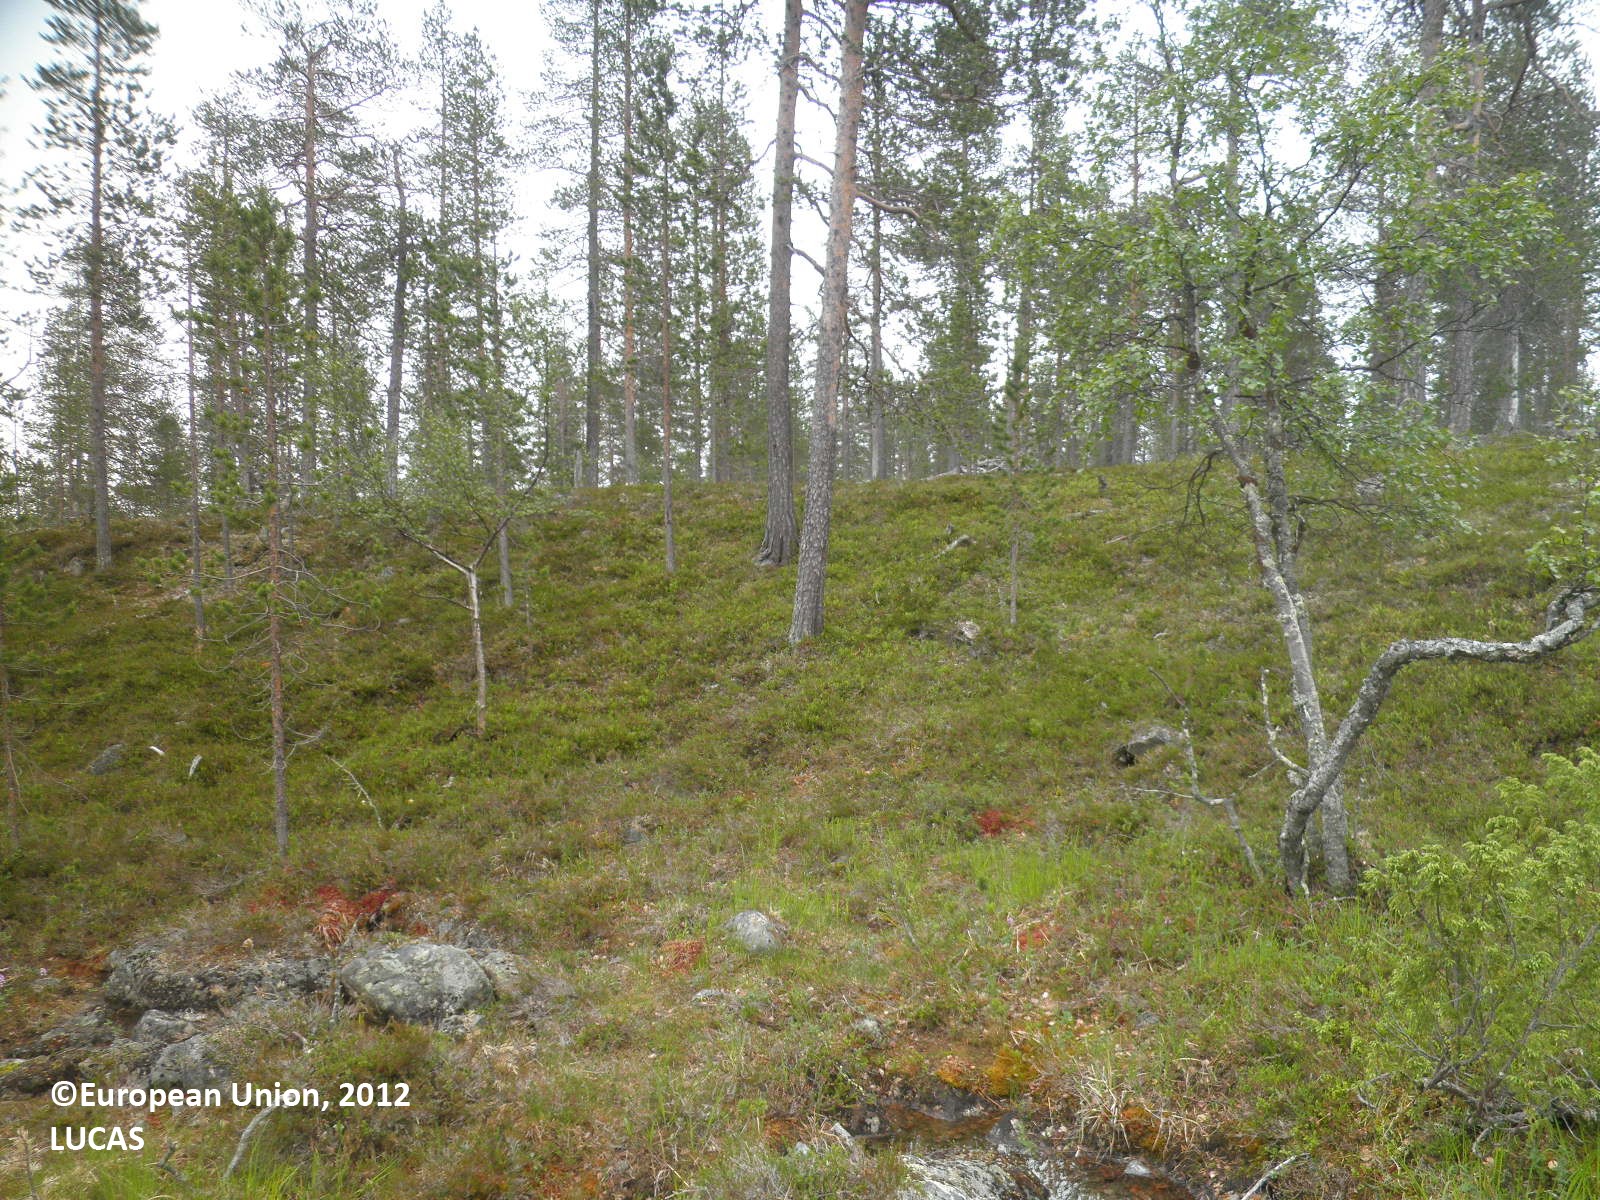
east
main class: Woodland
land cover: Pine dominated mixed woodland
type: boreal forest
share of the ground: 10 - 25 %
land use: Semi-natural and natural areas not in use
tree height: > 5 m
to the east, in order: Pine dominated mixed woodland; Rivers and streams; Pine dominated mixed woodland; Pine dominated coniferous woodland
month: July
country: FI
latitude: 68.5411
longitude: 27.7463
